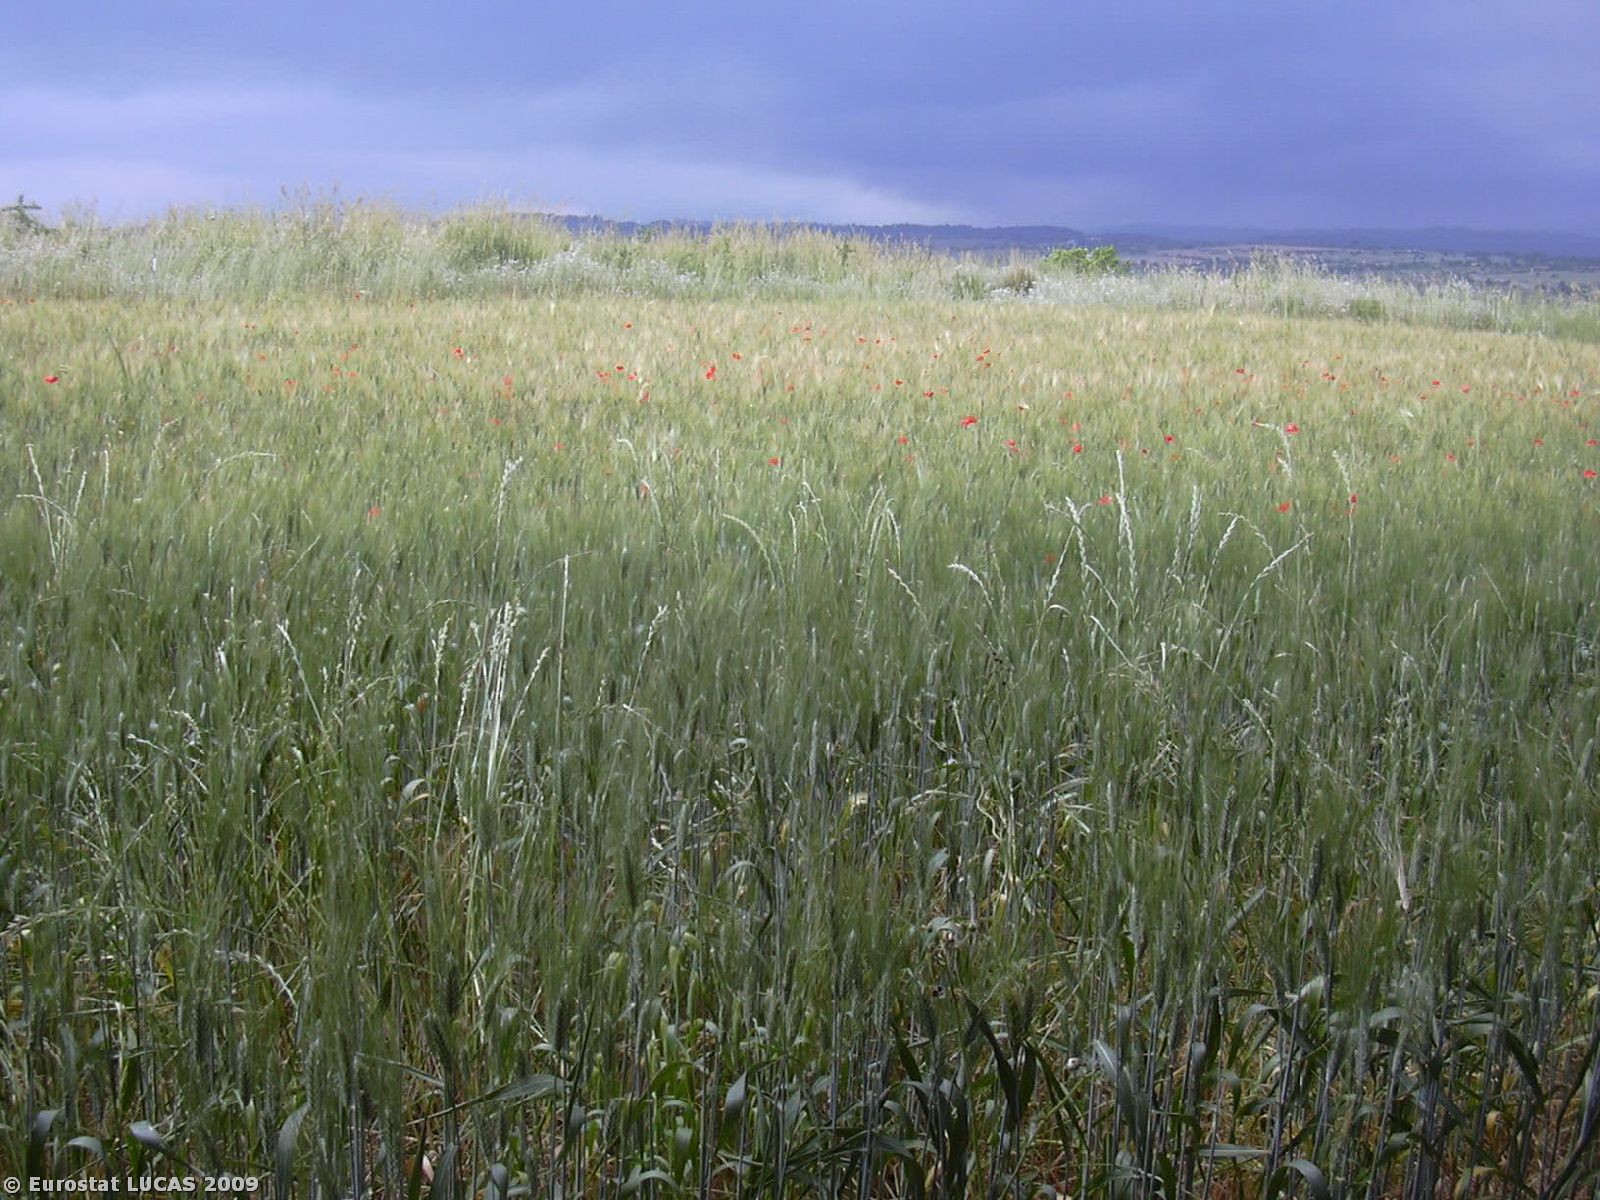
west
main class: Woodland
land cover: Broadleaved woodland
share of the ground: 50 - 75 %
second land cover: Durum wheat
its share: > 75 %
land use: Forestry
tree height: > 5 m
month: May
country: IT
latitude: 37.0732
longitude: 14.9447
